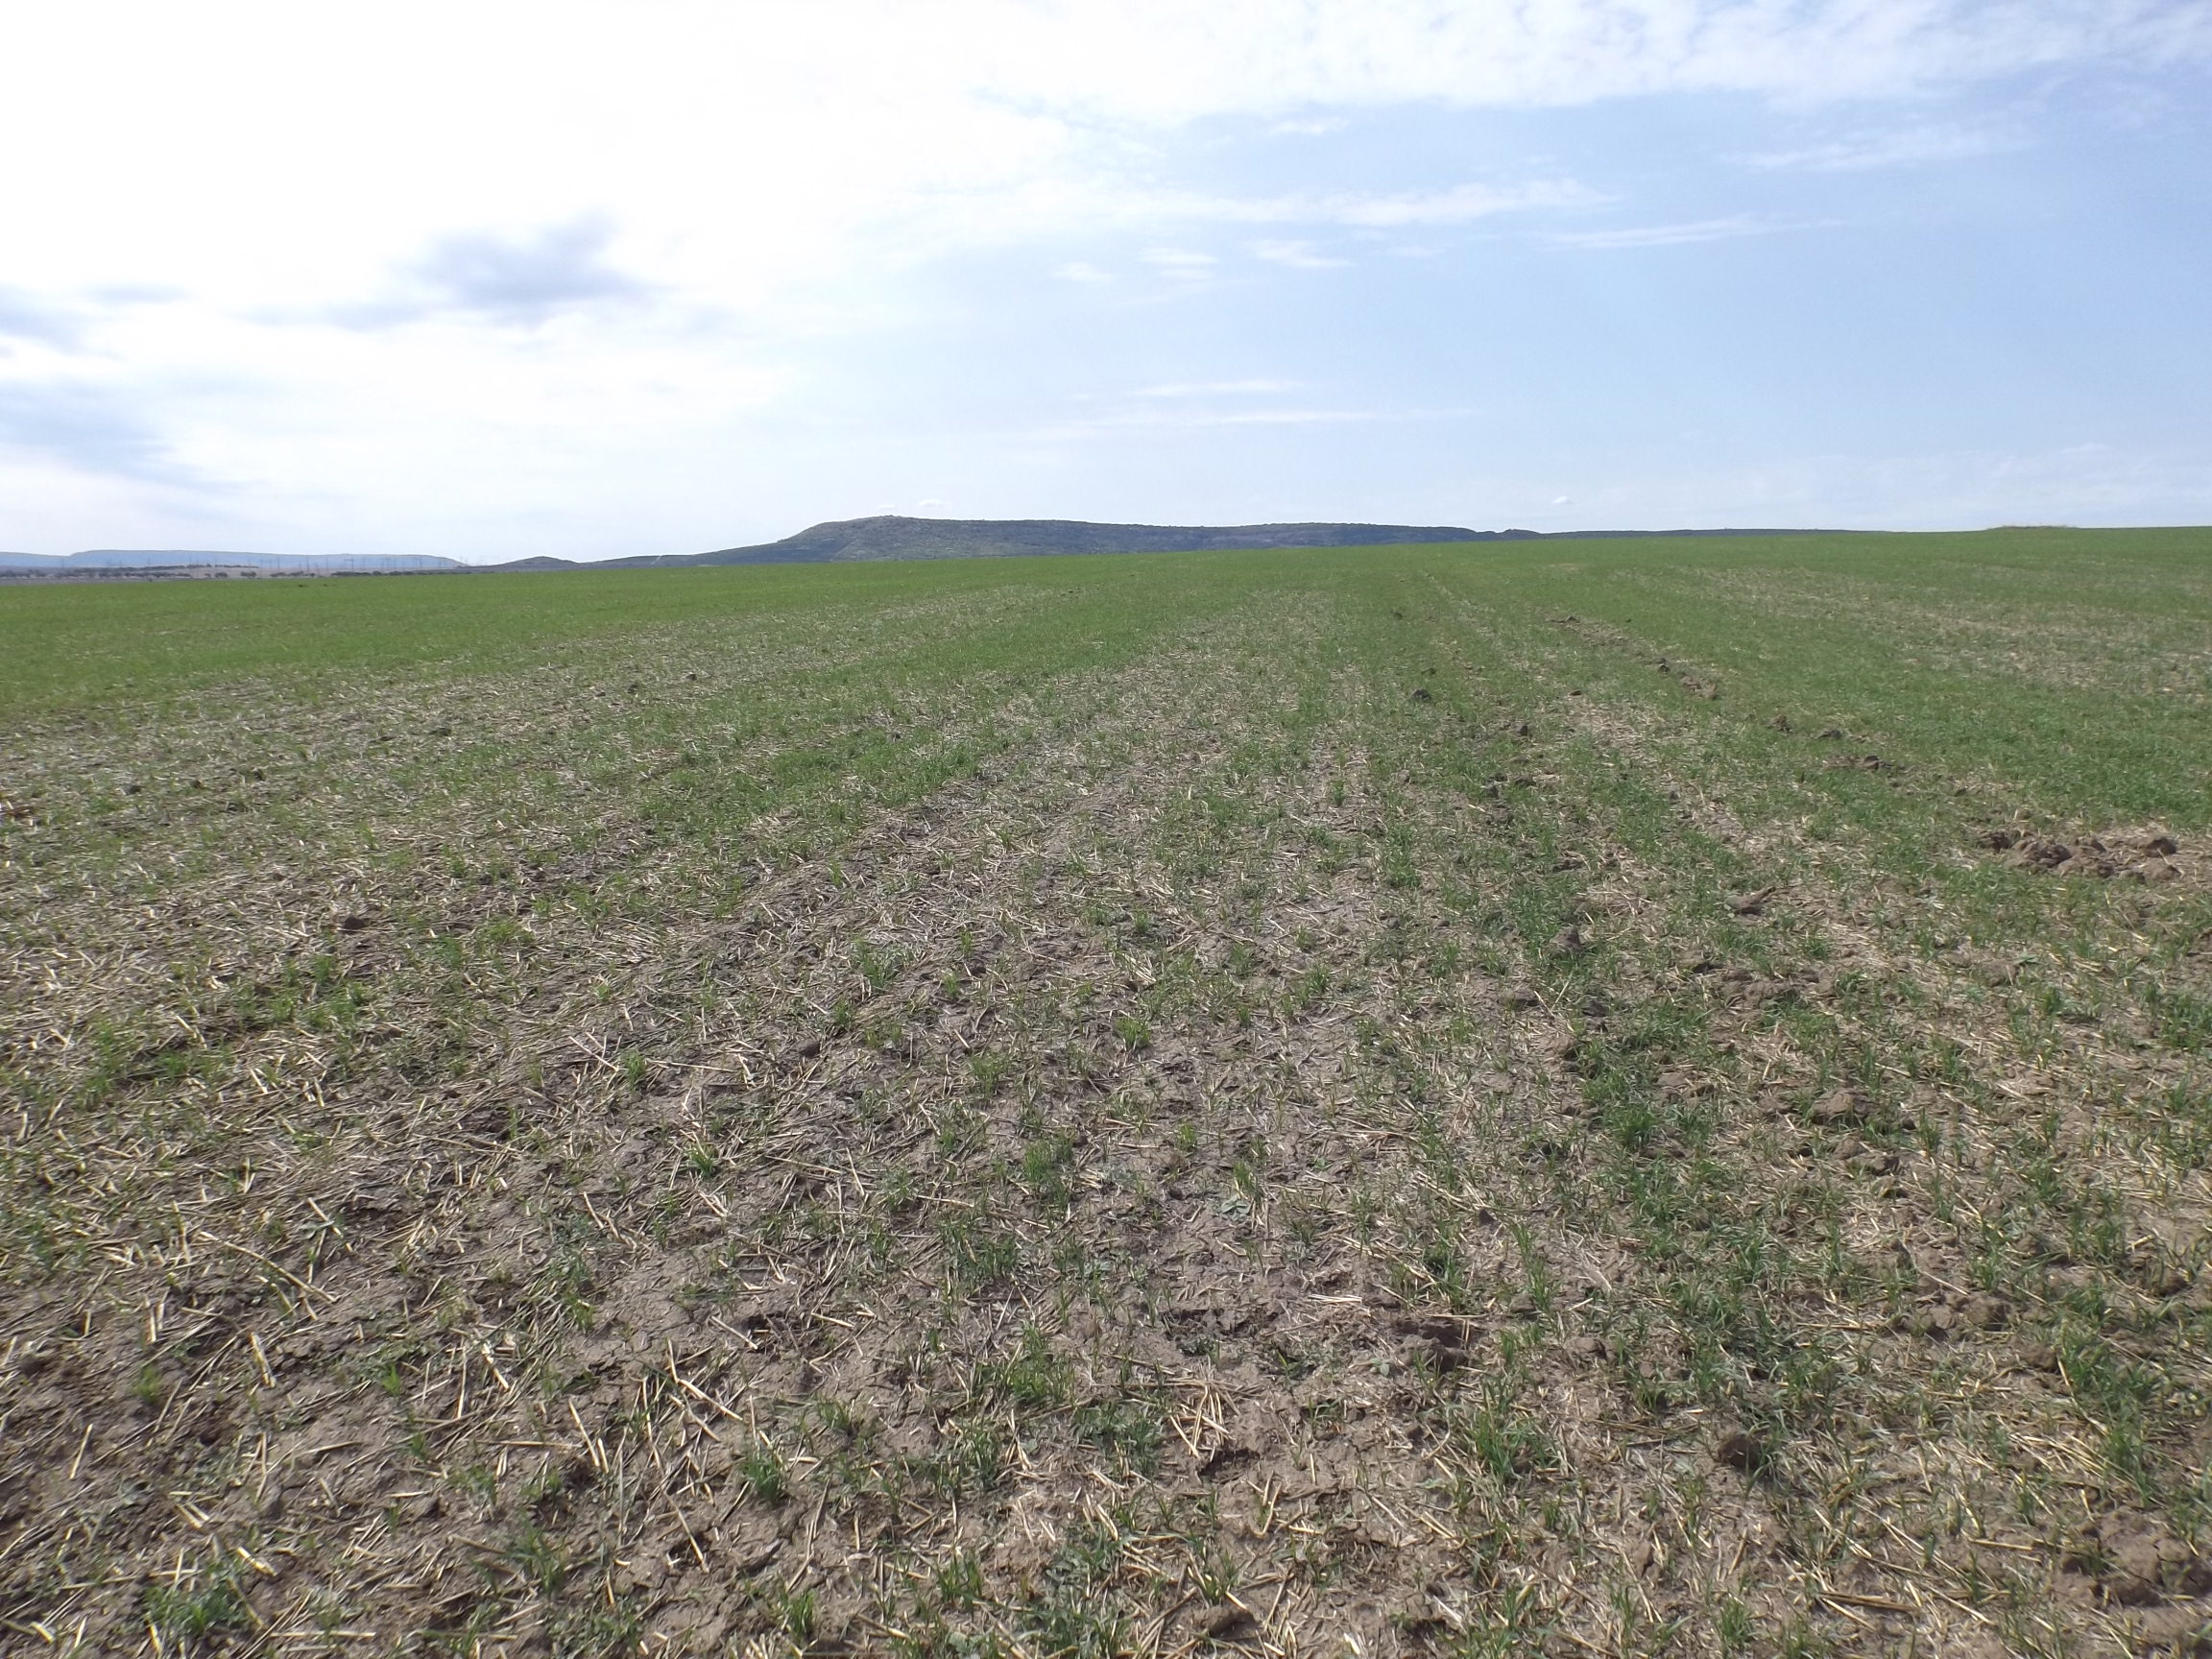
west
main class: Cropland
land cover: Common wheat
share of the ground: < 10 %
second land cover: Spontaneously vegetated surfaces
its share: 10 - 25 %
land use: Agriculture (excluding fallow land and kitchen gardens)
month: September
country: BG
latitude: 43.3306
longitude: 27.3795
